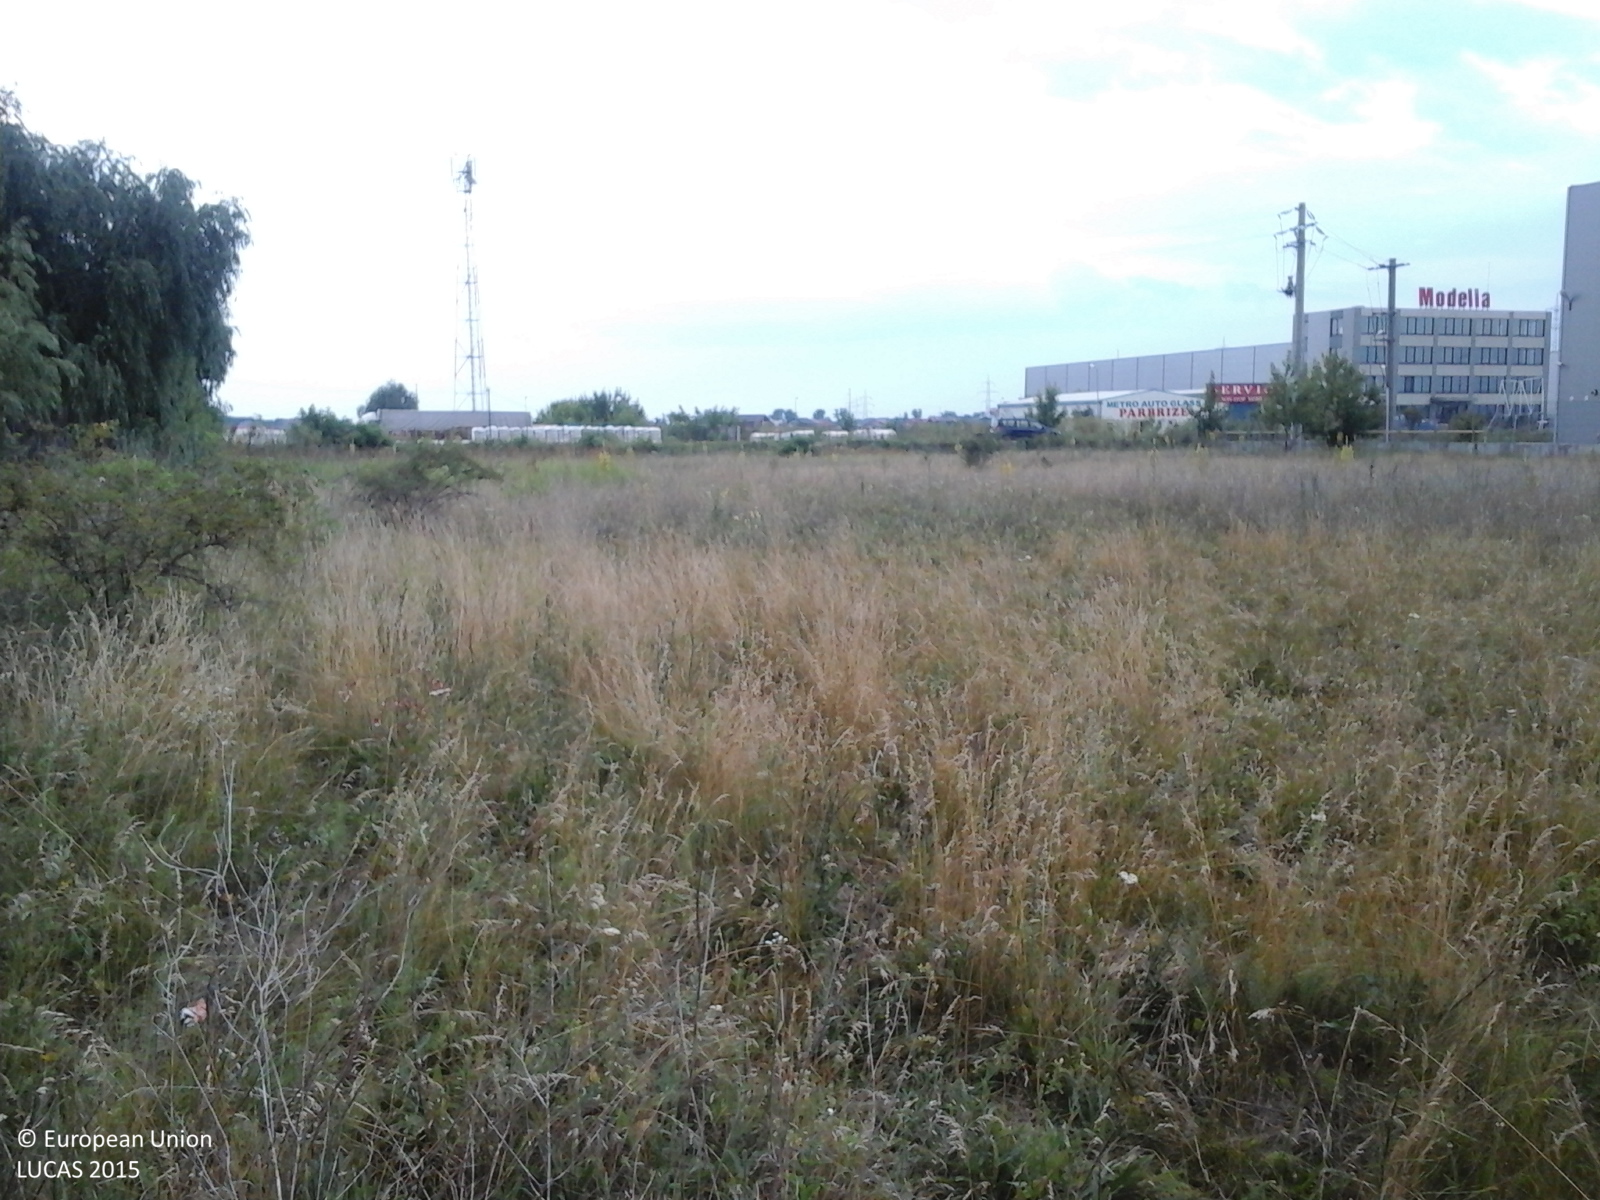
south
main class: Grassland
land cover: Spontaneously vegetated surfaces
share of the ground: > 75 %
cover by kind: herbaceous plants 100 %
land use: Fallow land
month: June
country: RO
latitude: 44.4541
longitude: 26.2579
